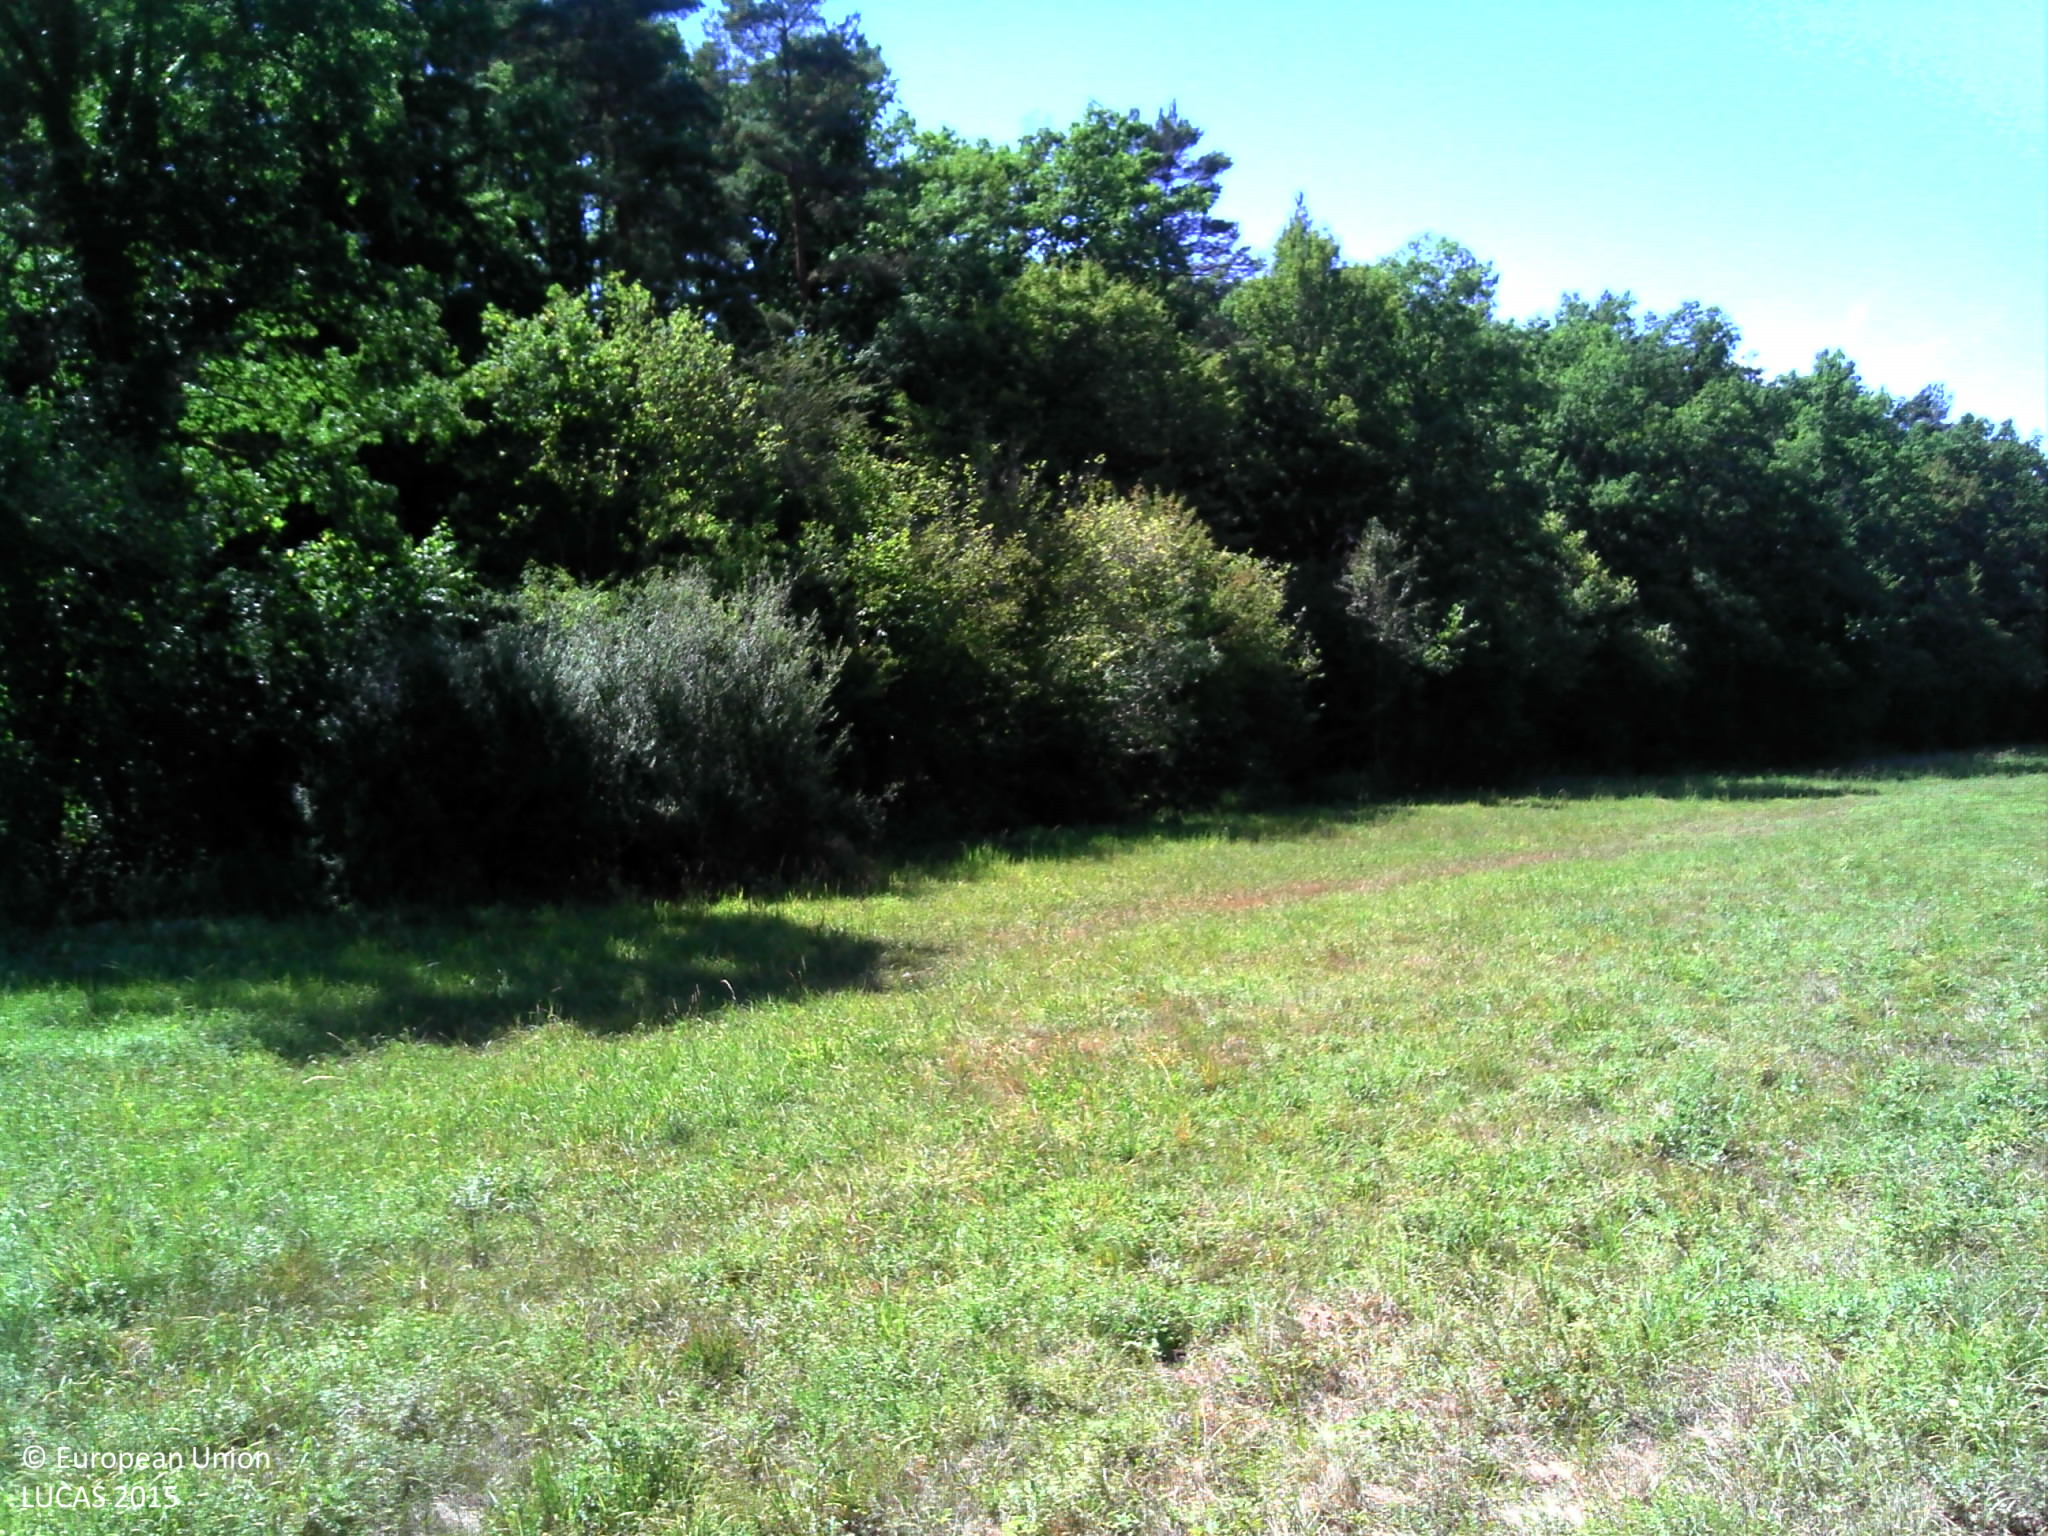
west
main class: Grassland
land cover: Grassland without tree/shrub cover
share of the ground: > 75 %
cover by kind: herbaceous plants 100 %
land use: Agriculture (excluding fallow land and kitchen gardens)
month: August
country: FR
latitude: 47.8069
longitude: 5.0724
